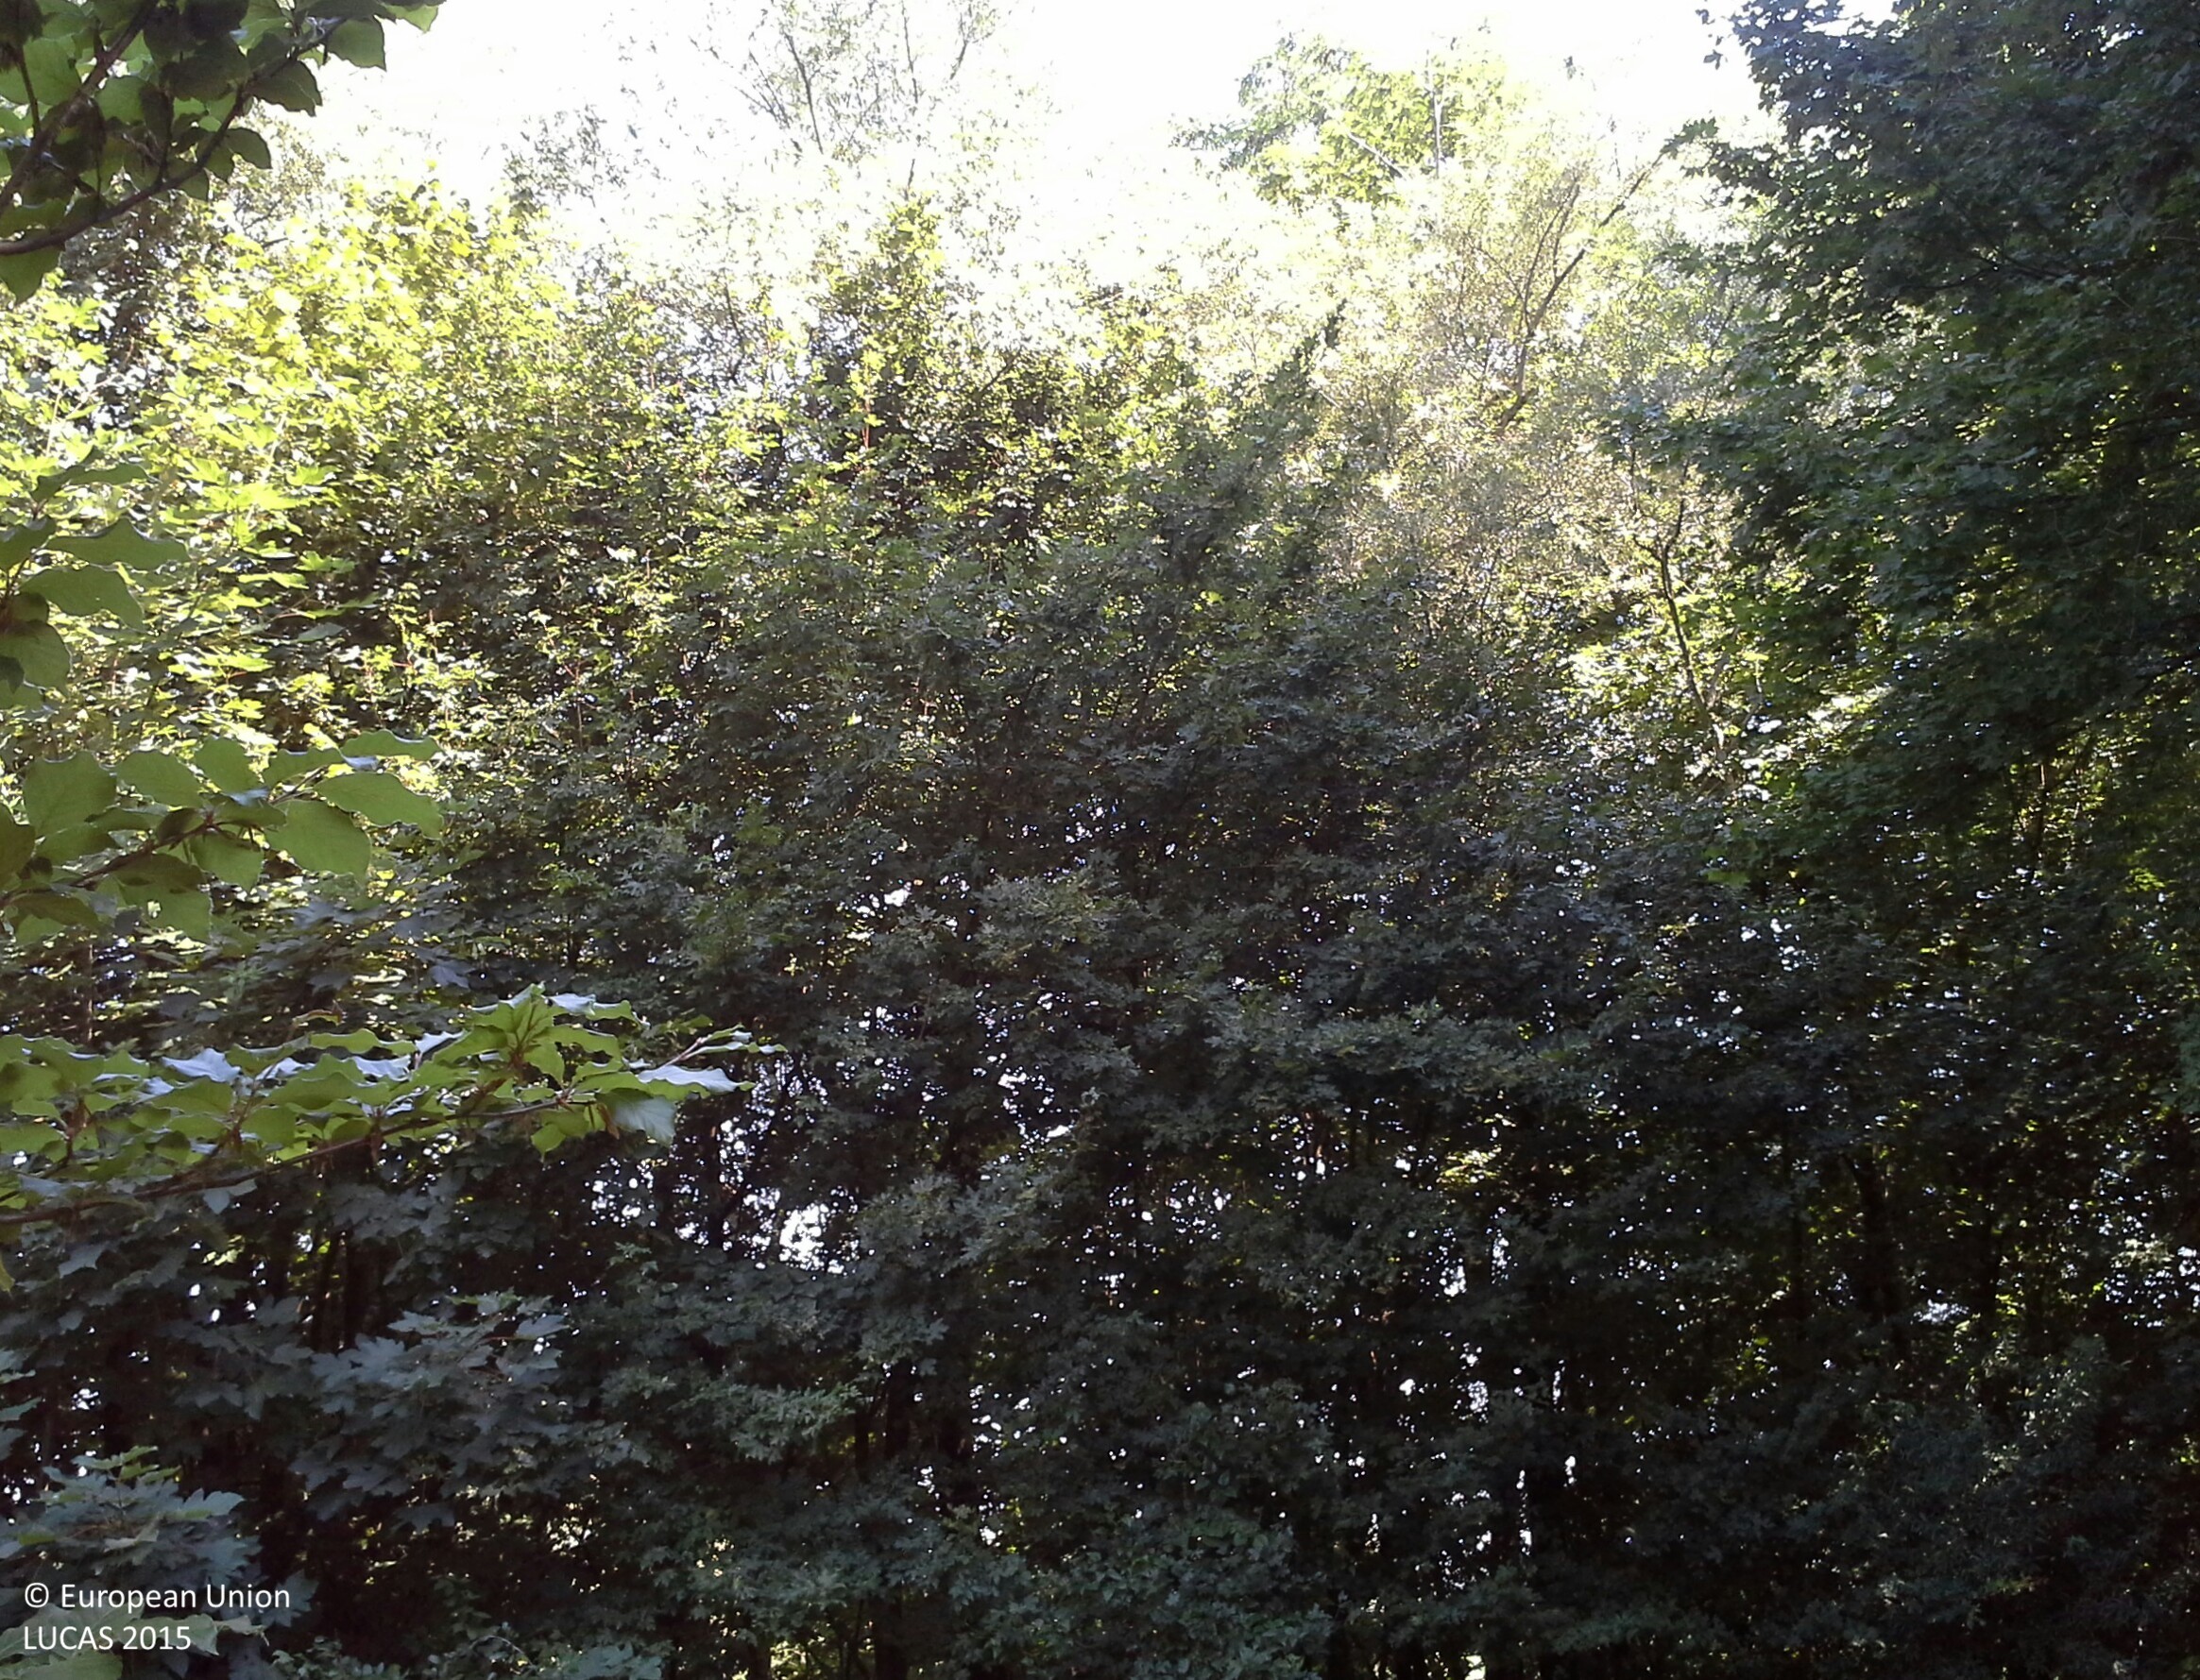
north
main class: Woodland
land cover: Broadleaved woodland
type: mesophytic deciduous forest
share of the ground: > 75 %
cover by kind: broadleaved forest trees 70 %, shrubs 15 %, herbaceous plants 15 %
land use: Forestry
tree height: < 5 m
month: July
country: AT
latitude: 48.0989
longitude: 14.8483
